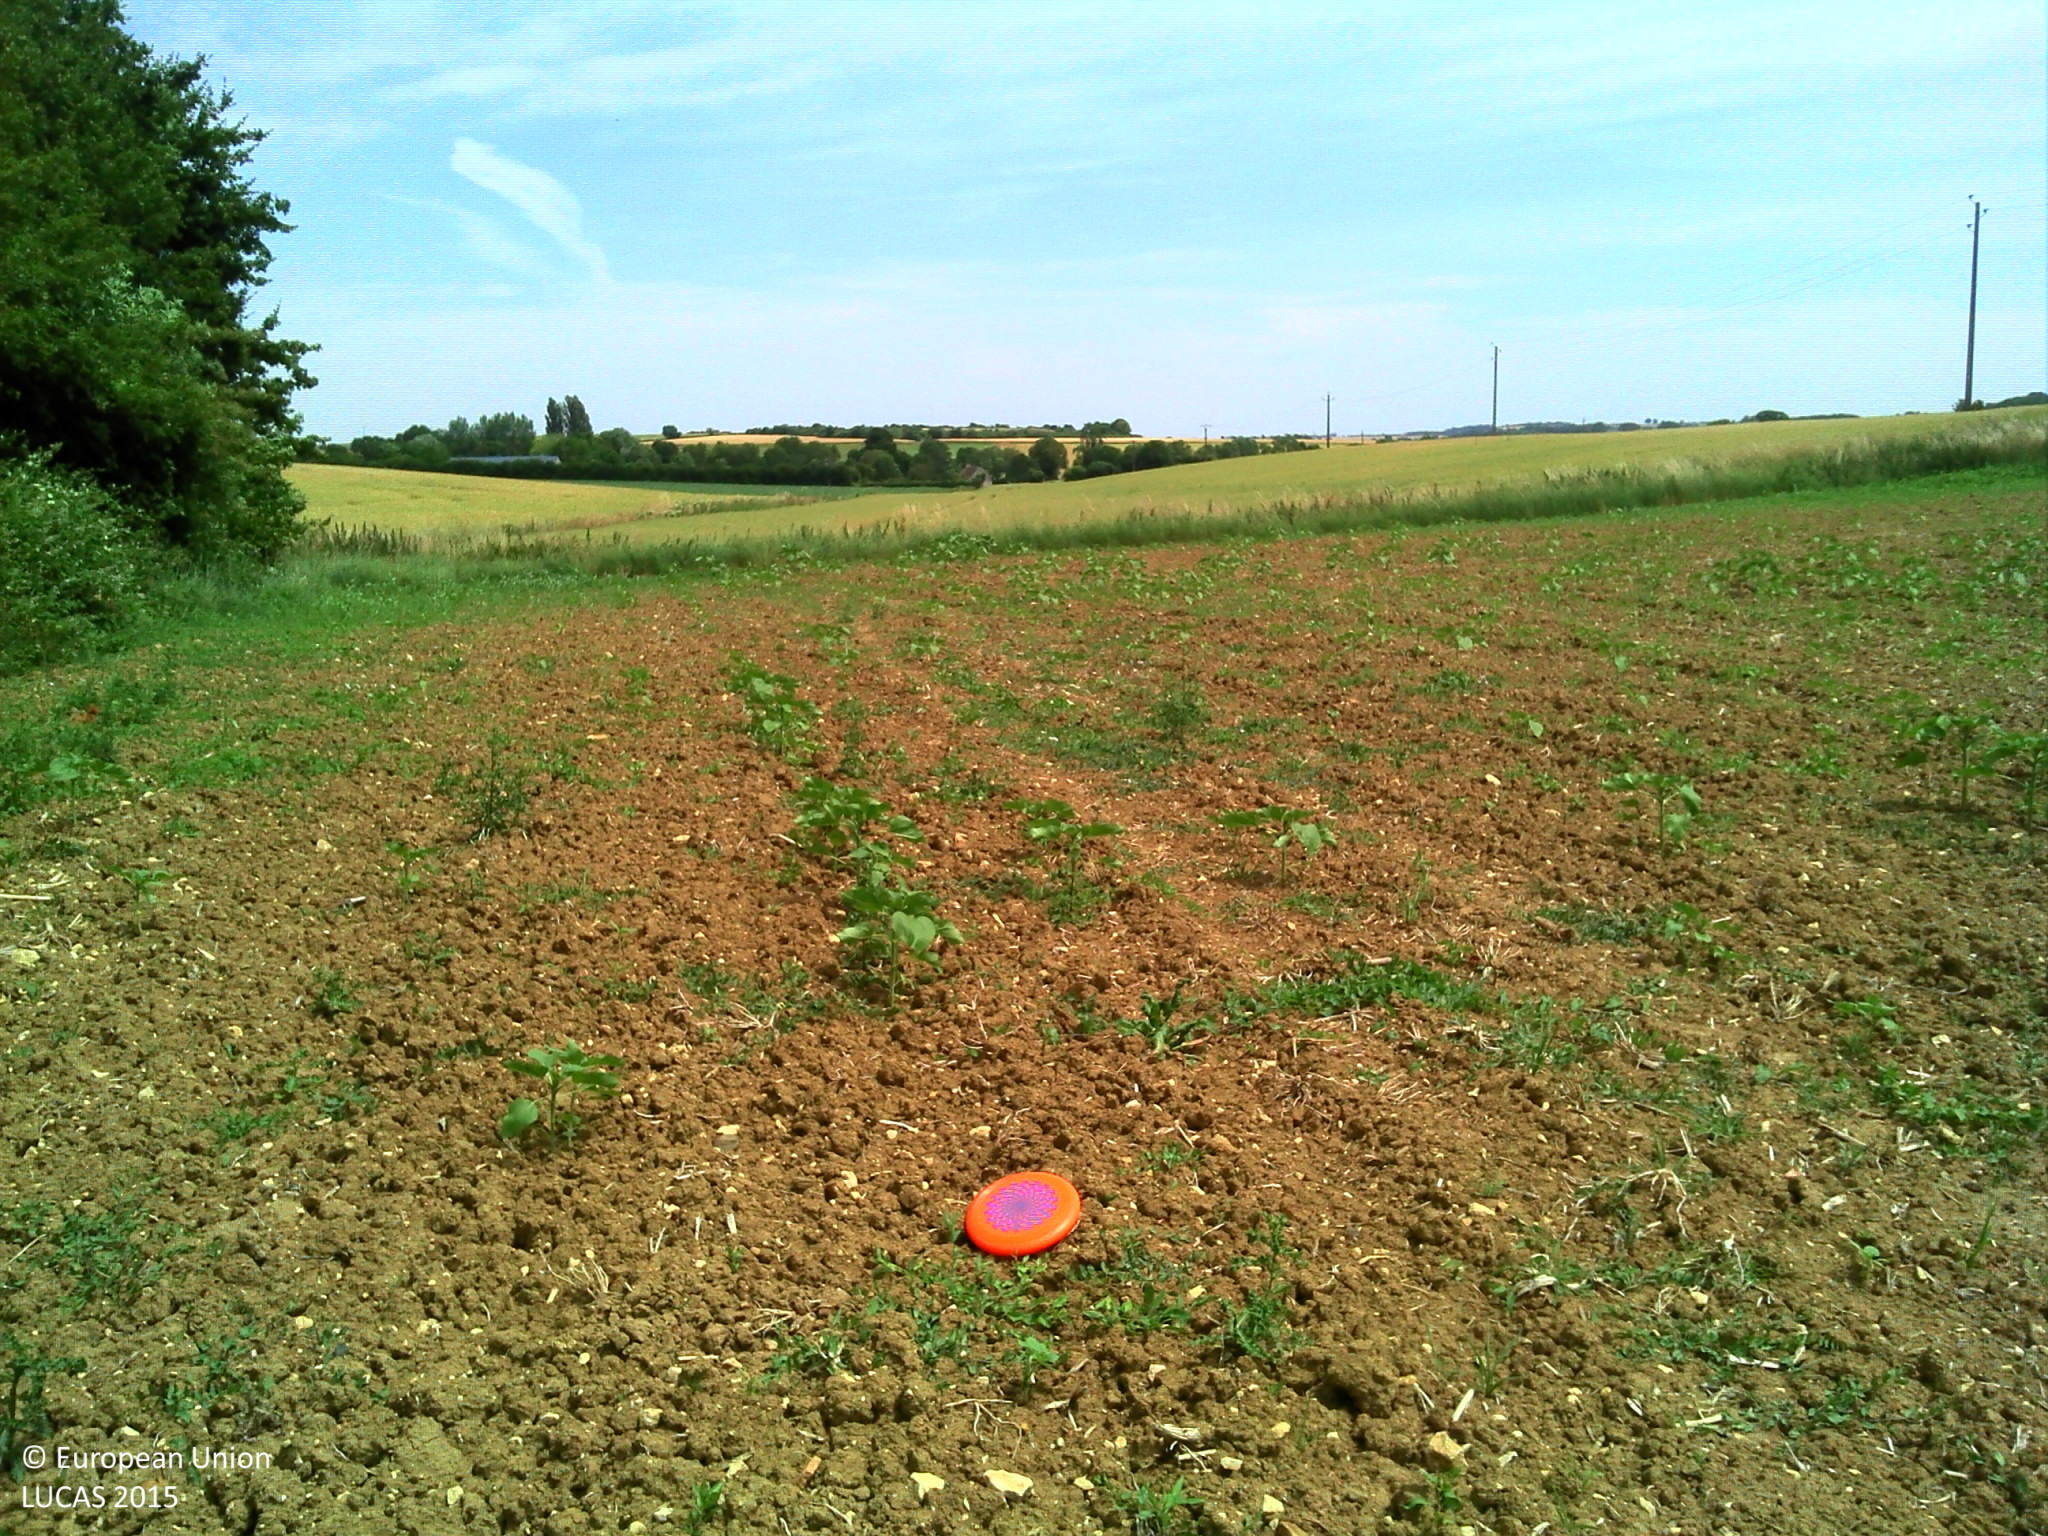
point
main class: Cropland
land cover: Sunflower
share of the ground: < 10 %
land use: Agriculture (excluding fallow land and kitchen gardens)
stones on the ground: > 50 %
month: June
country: FR
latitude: 48.3089
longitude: 0.1704
